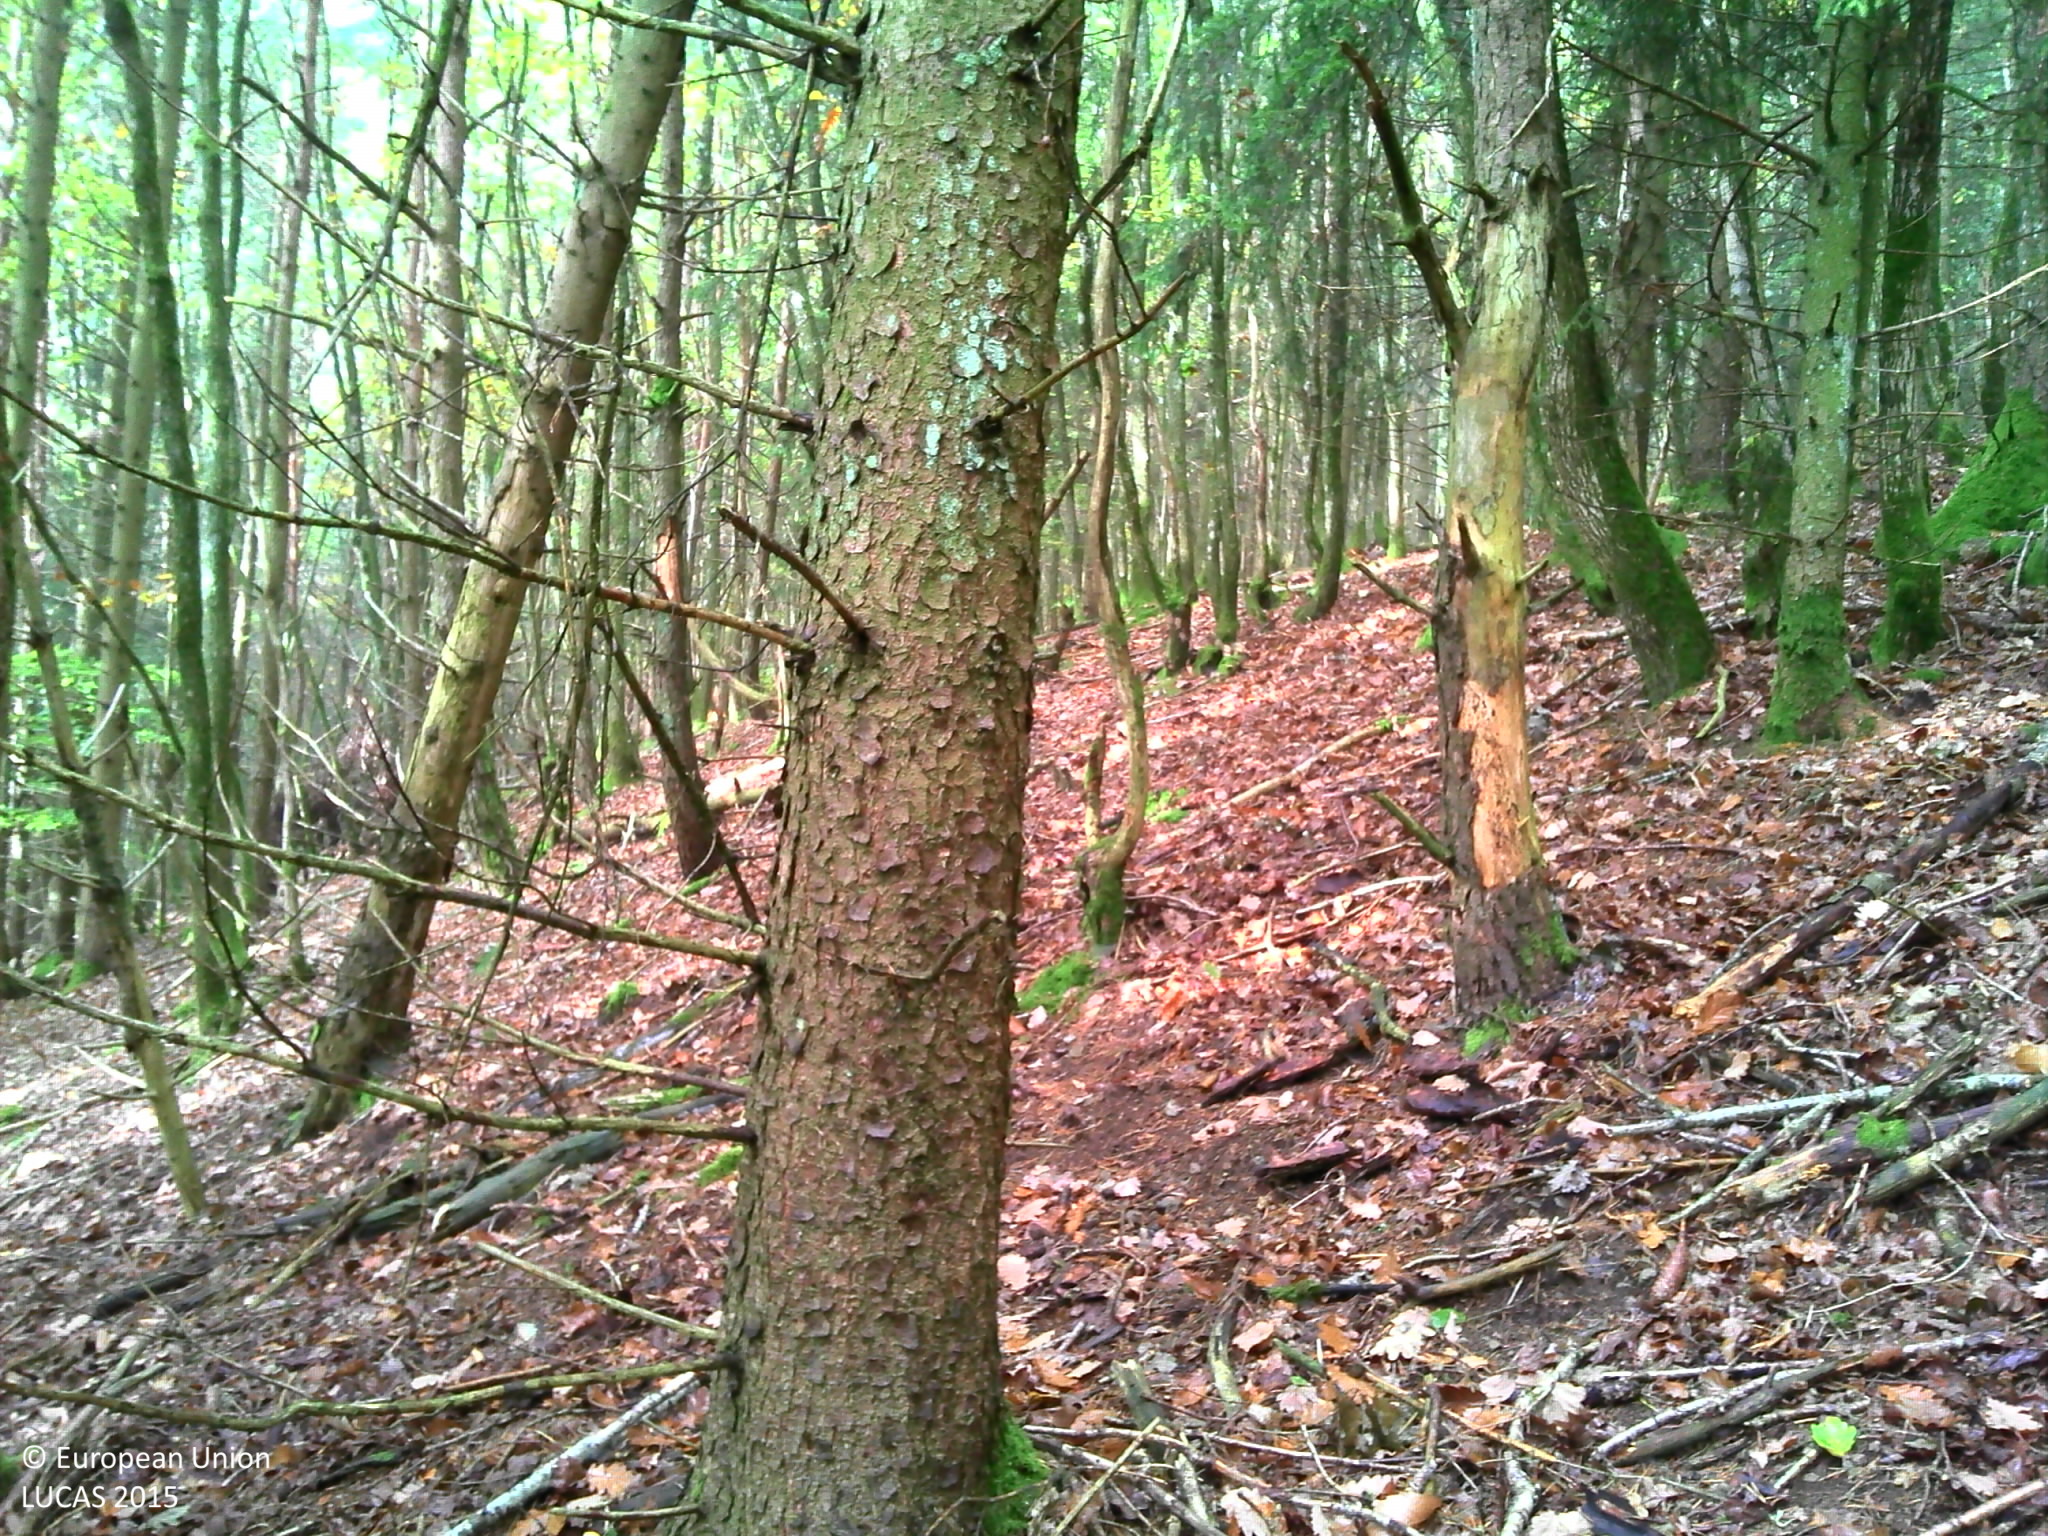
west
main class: Woodland
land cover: Spruce dominated mixed woodland
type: hemiboreal forest and nemoral coniferous forest and mixed broadleaved-coniferous forest
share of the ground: > 75 %
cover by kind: coniferous forest trees 60 %, broadleaved forest trees 25 %, herbaceous plants 15 %
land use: Forestry
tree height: > 5 m
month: October
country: FR
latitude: 46.1437
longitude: 2.7865
